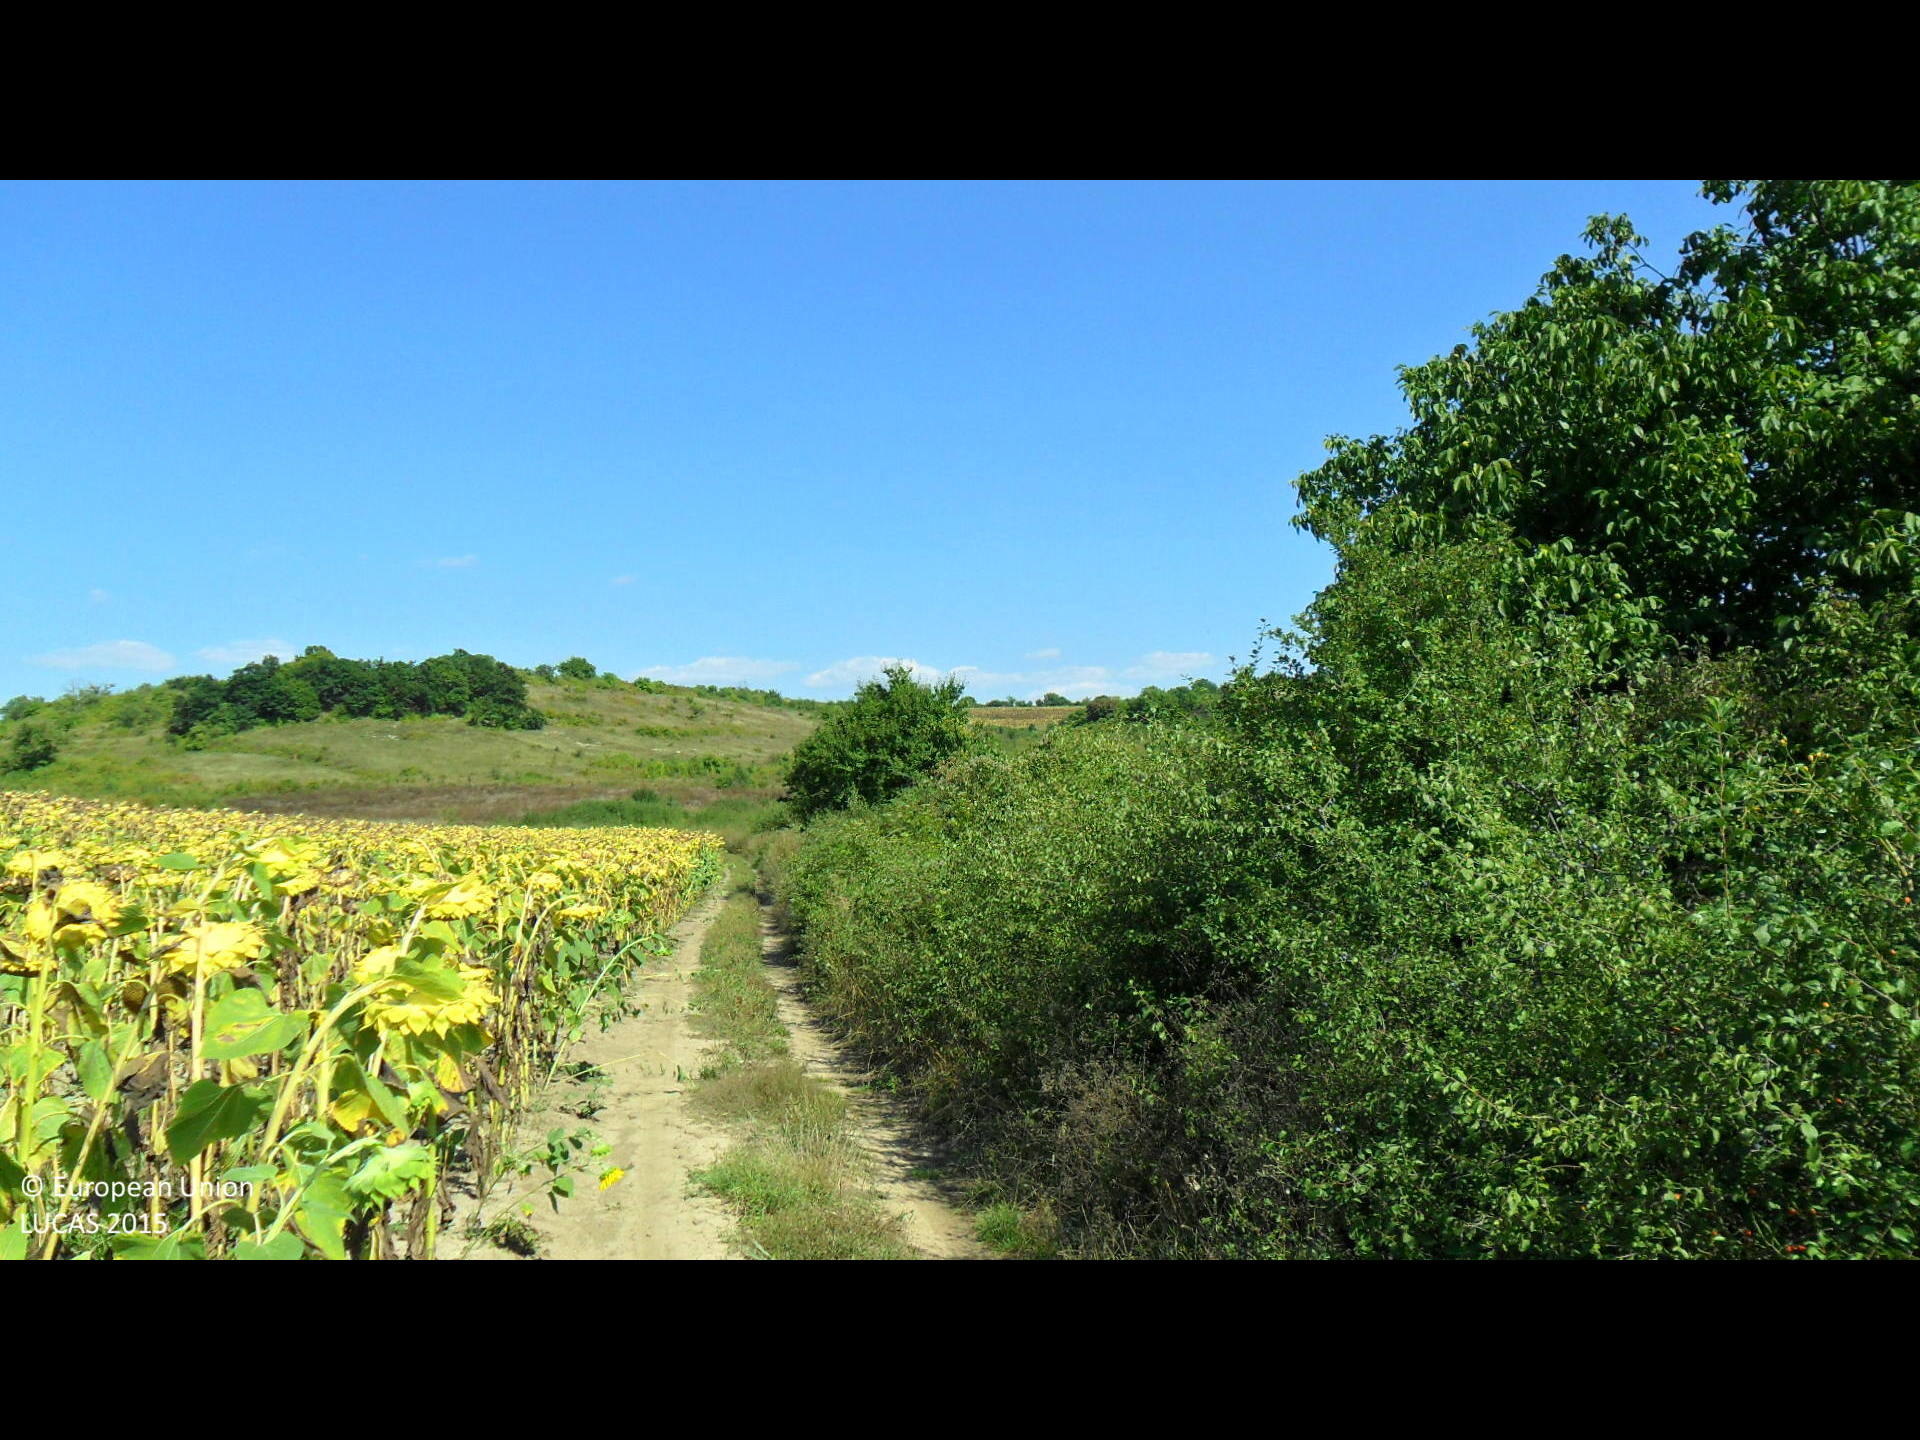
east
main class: Cropland
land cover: Sunflower
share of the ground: > 75 %
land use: Agriculture (excluding fallow land and kitchen gardens)
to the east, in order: Sunflower; Shruby margins; Sunflower; Grassland with sparse tree/shrub cover
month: August
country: BG
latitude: 43.4650
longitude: 26.3545
